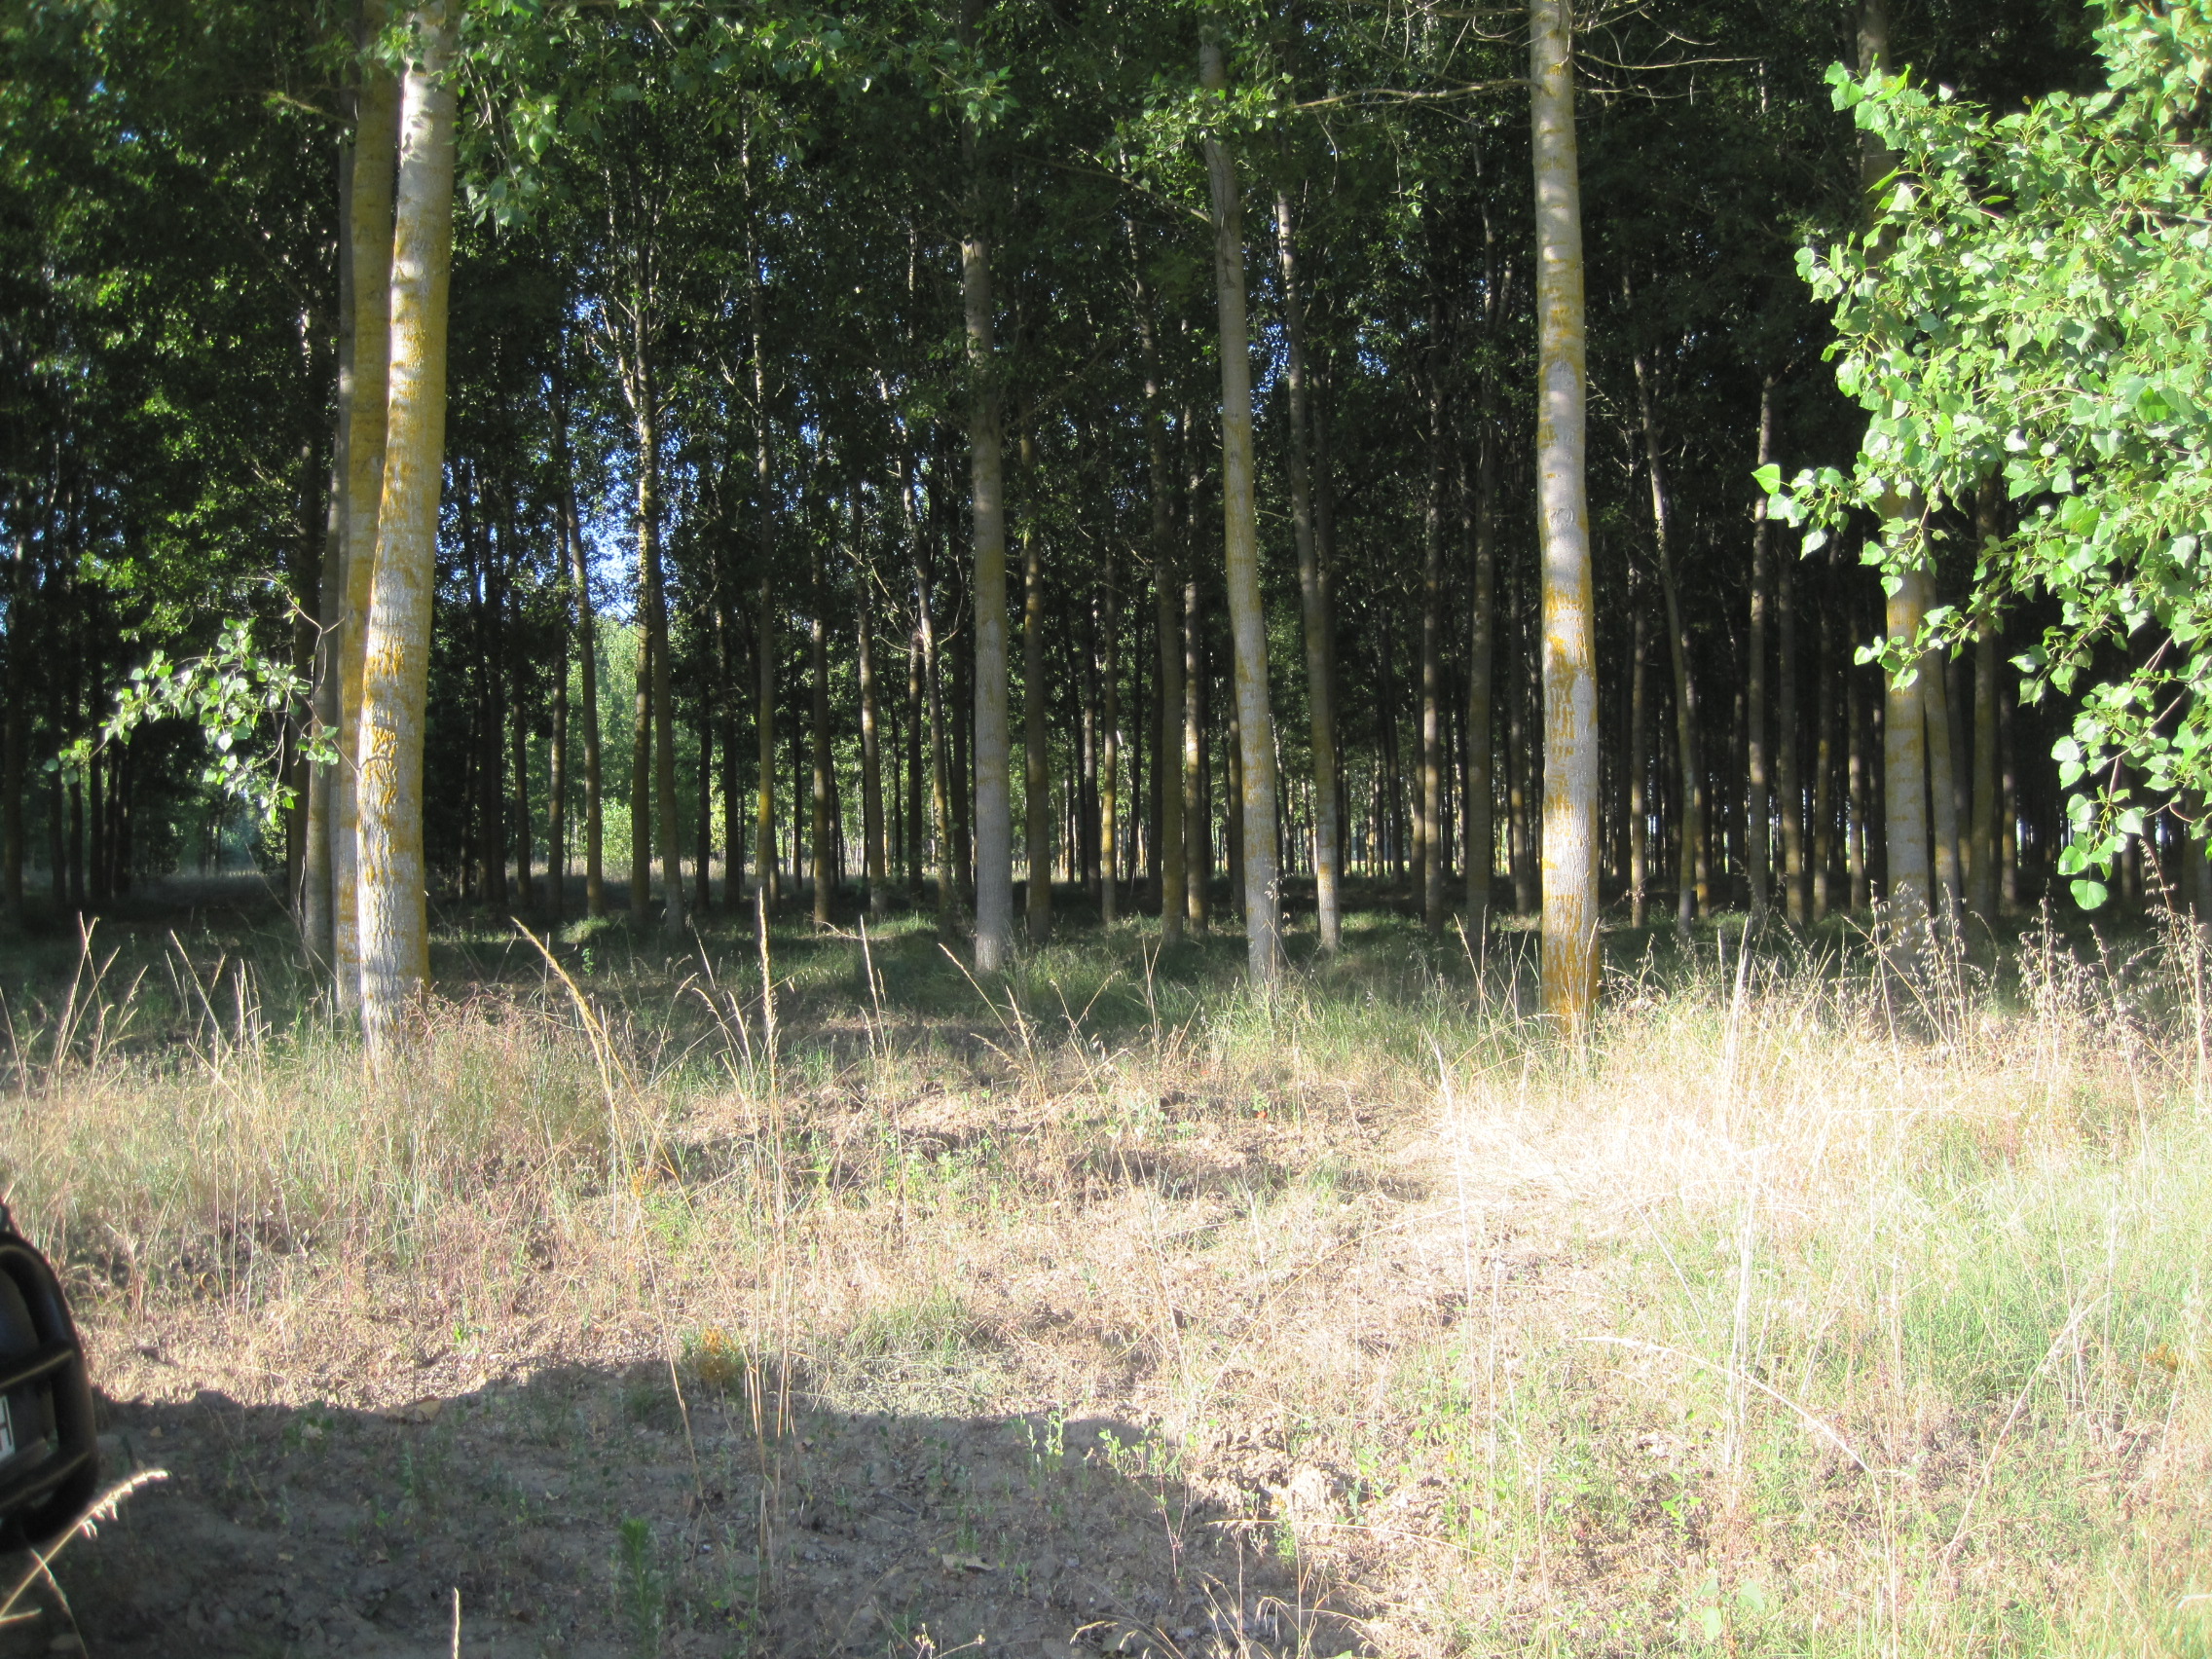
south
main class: Cropland
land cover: Maize
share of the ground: > 75 %
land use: Agriculture (excluding fallow land and kitchen gardens)
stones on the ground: < 10 %
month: July
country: ES
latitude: 42.0050
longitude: -5.6051
